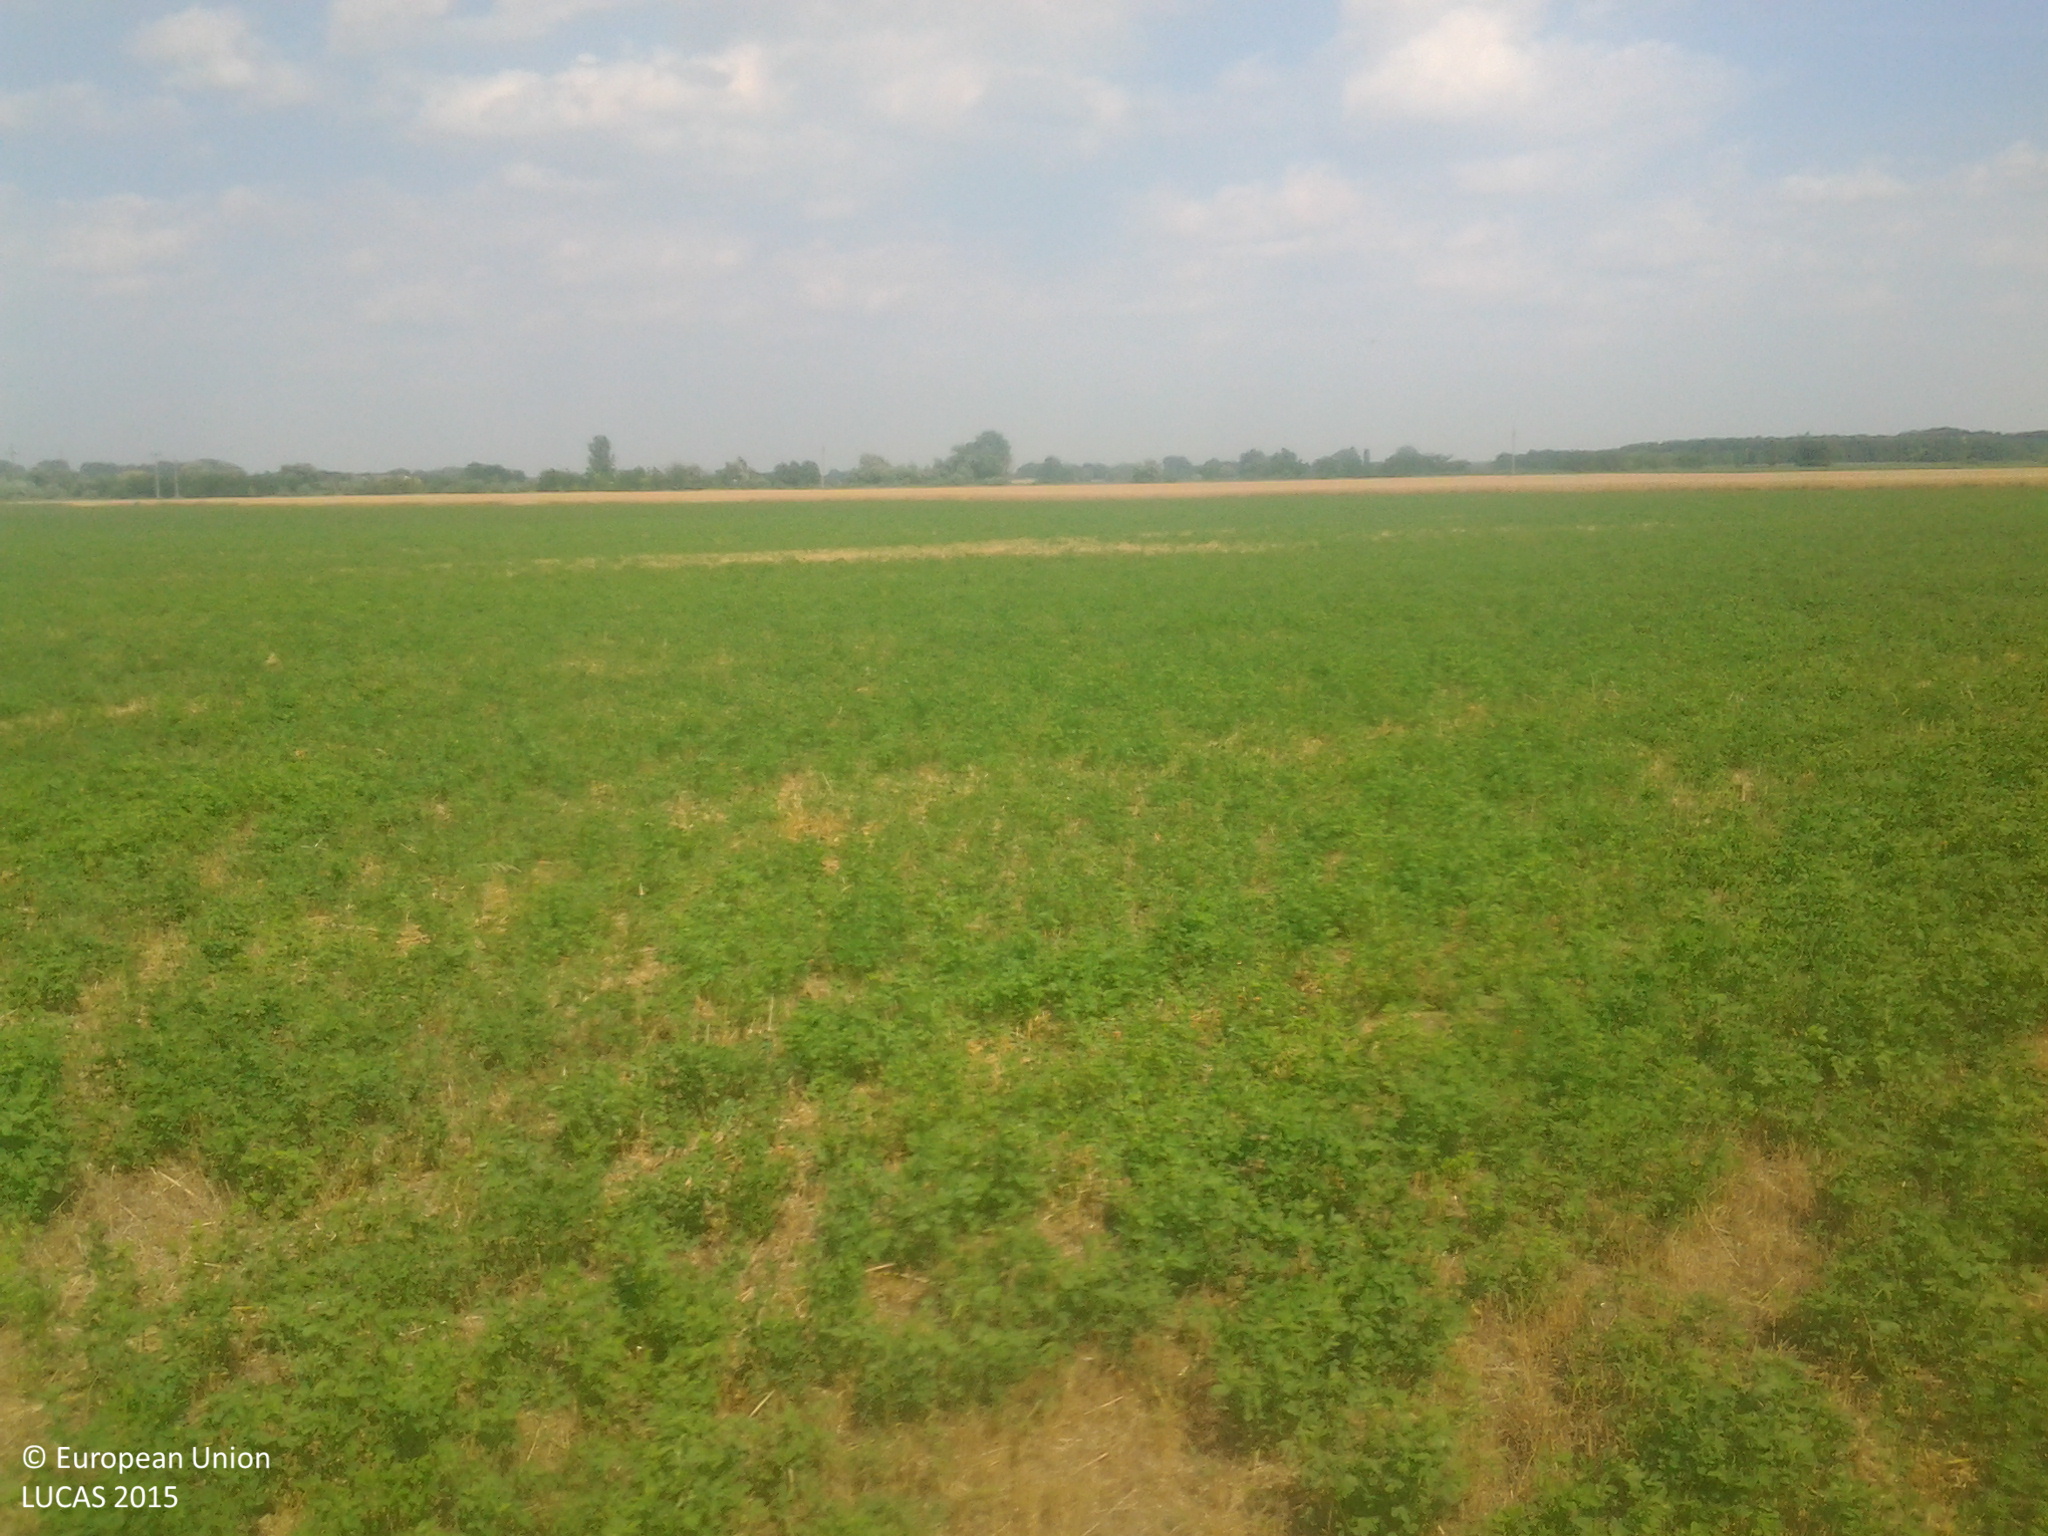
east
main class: Cropland
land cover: Lucerne
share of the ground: > 75 %
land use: Agriculture (excluding fallow land and kitchen gardens)
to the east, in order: Lucerne; Barley
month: July
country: HU
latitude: 47.0553
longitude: 19.2461
